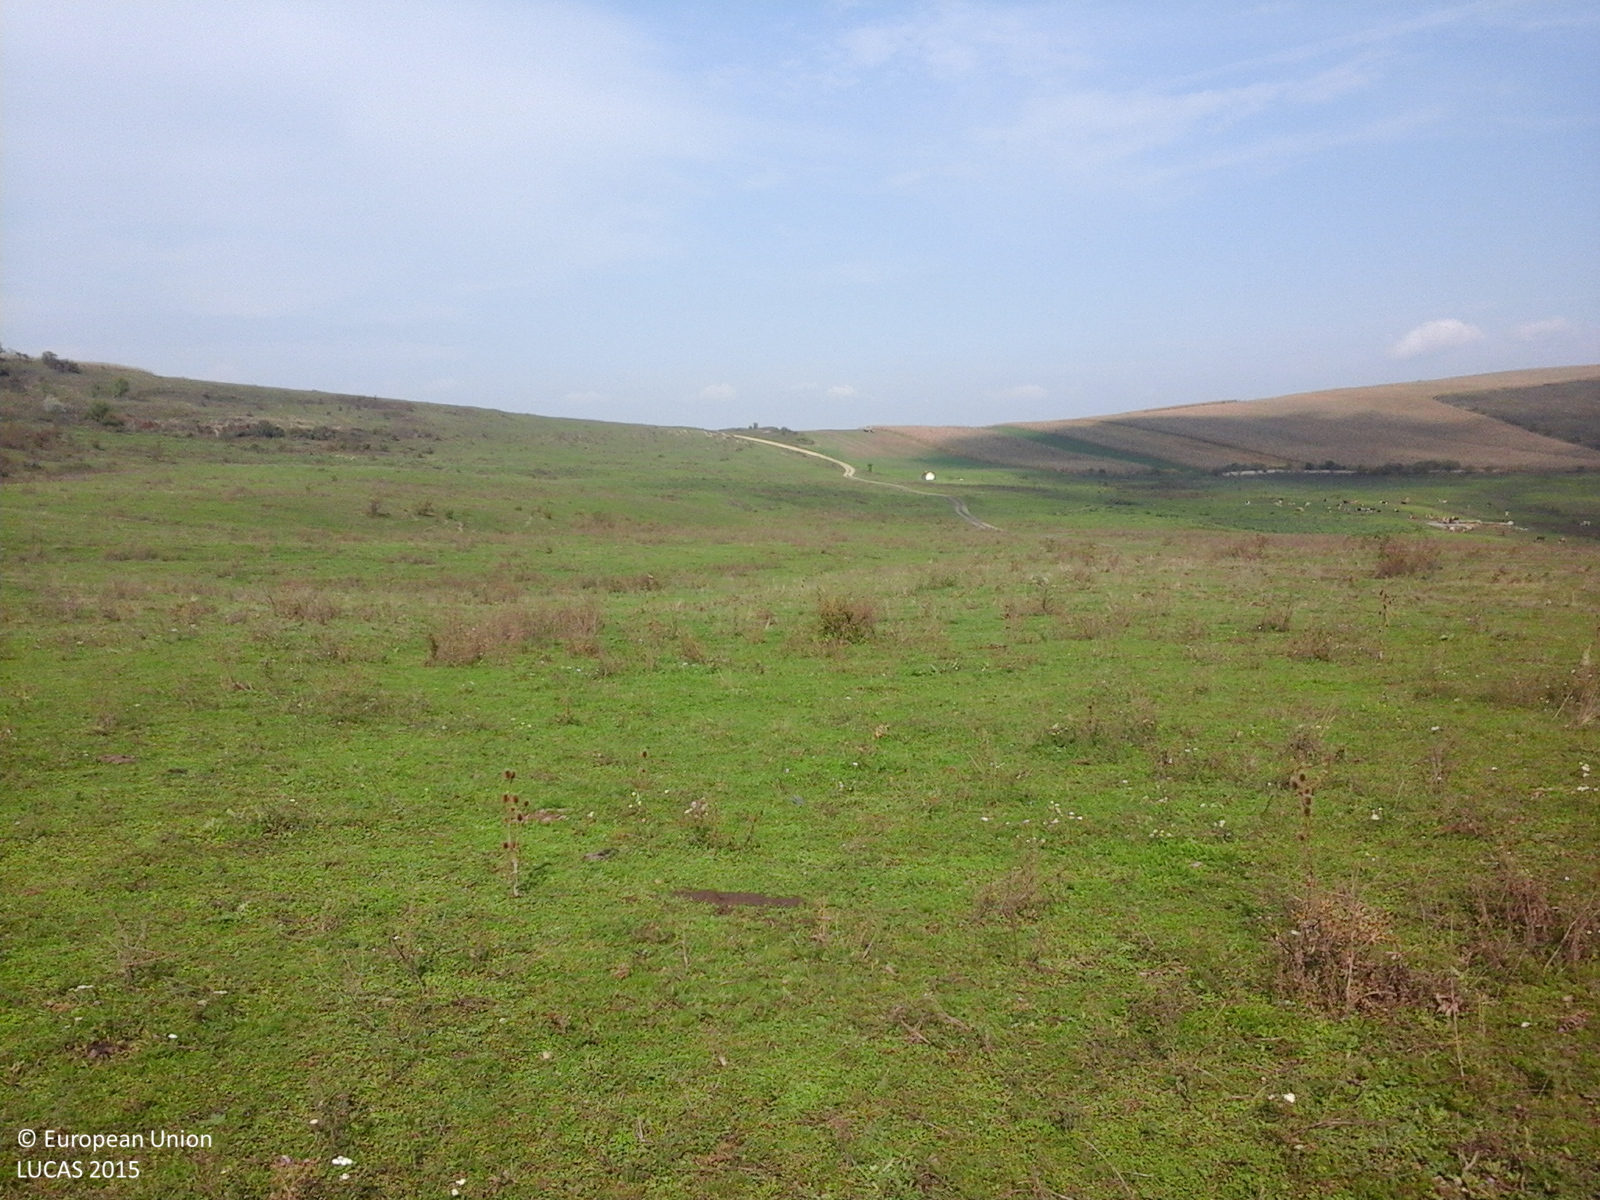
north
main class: Grassland
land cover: Spontaneously vegetated surfaces
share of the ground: > 75 %
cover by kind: herbaceous plants 100 %
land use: Agriculture (excluding fallow land and kitchen gardens)
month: October
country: RO
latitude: 46.4657
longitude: 23.8645
